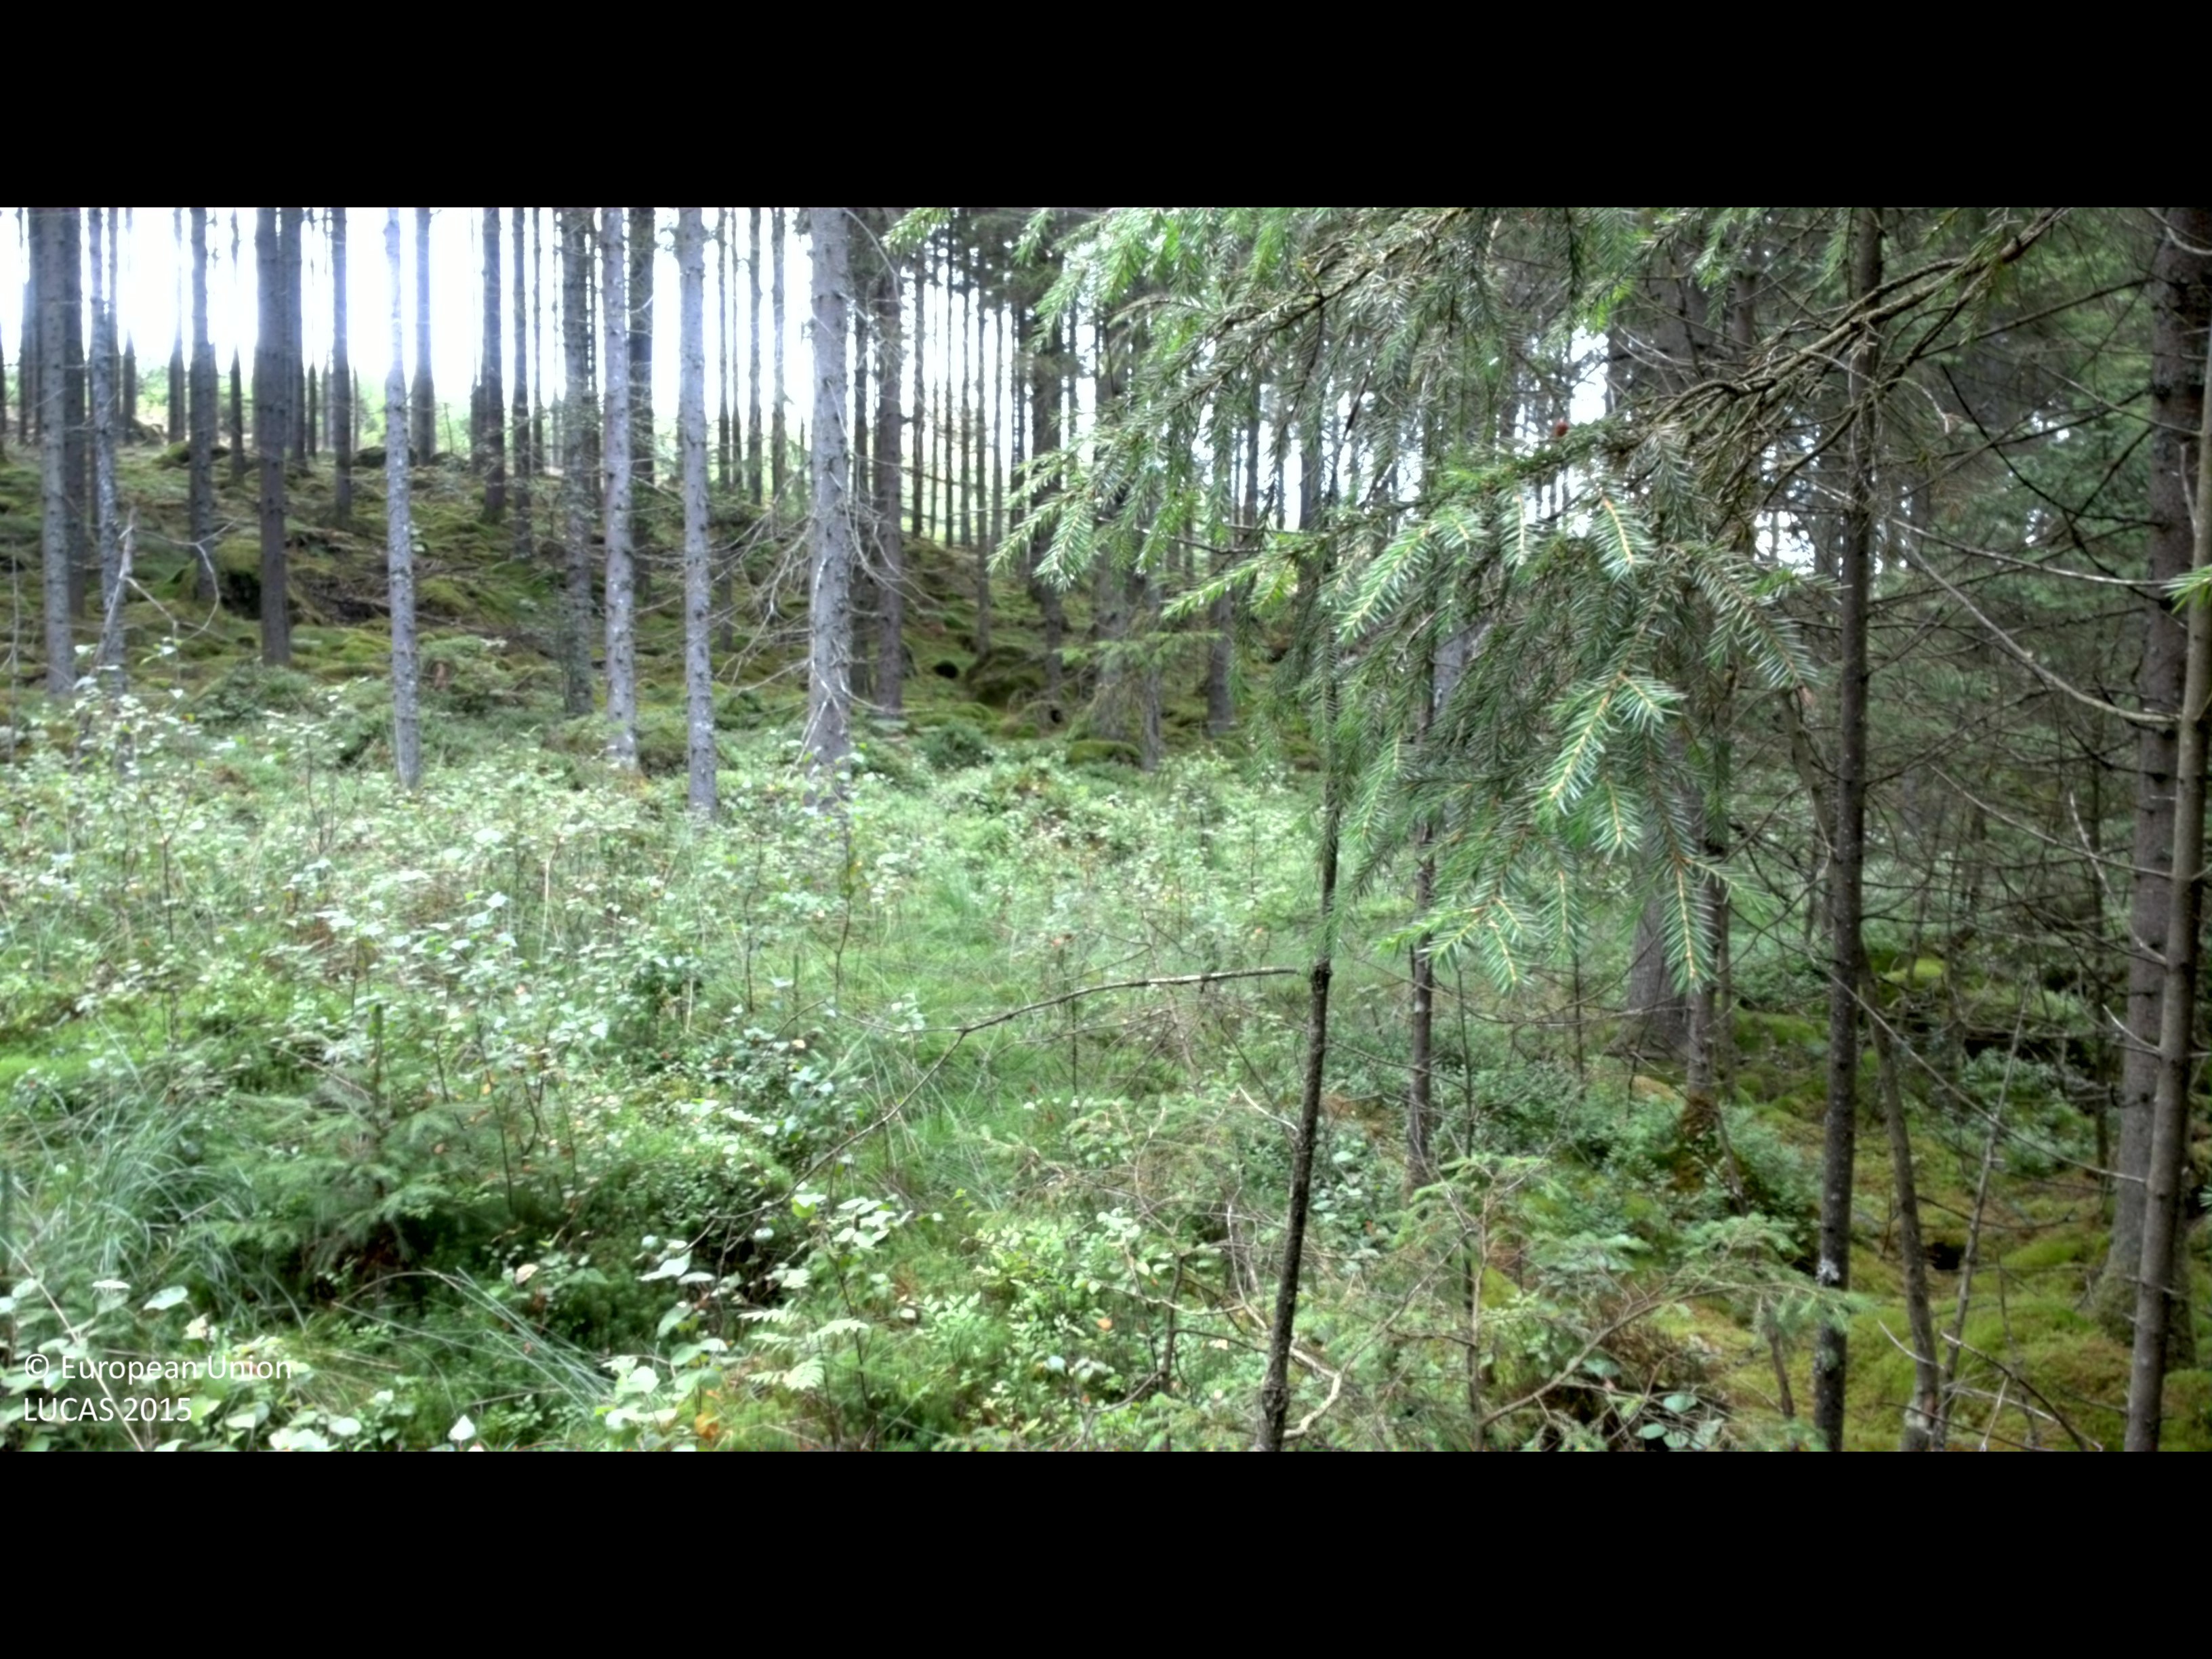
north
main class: Woodland
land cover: Spruce dominated coniferous woodland
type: boreal forest
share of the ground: 50 - 75 %
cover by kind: coniferous forest trees 60 %, shrubs 30 %, broadleaved forest trees 5 %, lichens and mosses 5 %
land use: Forestry
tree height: > 5 m
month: August
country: SE
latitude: 57.0465
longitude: 13.2435
